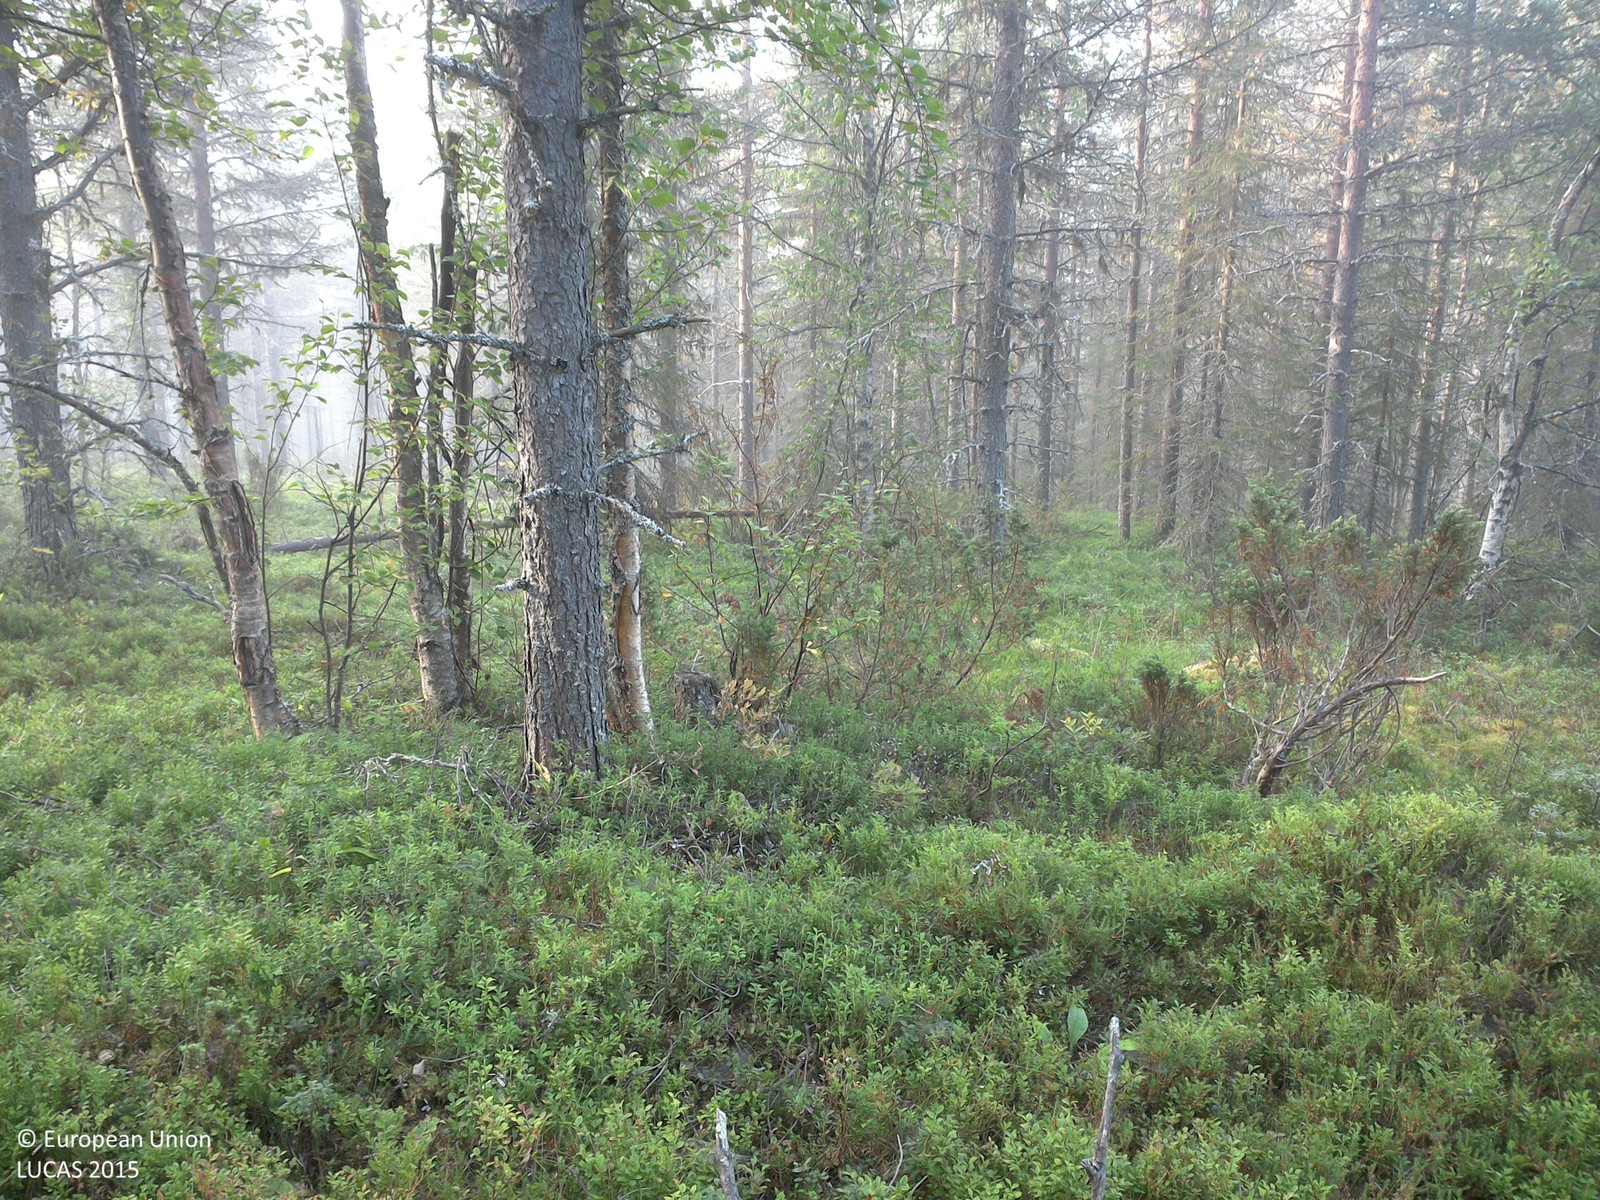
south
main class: Woodland
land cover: Pine dominated coniferous woodland
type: boreal forest
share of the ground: 25 - 50 %
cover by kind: shrubs 60 %, coniferous forest trees 30 %, broadleaved forest trees 5 %, lichens and mosses 5 %
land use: Forestry
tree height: > 5 m
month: August
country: SE
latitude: 67.1224
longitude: 21.8746
